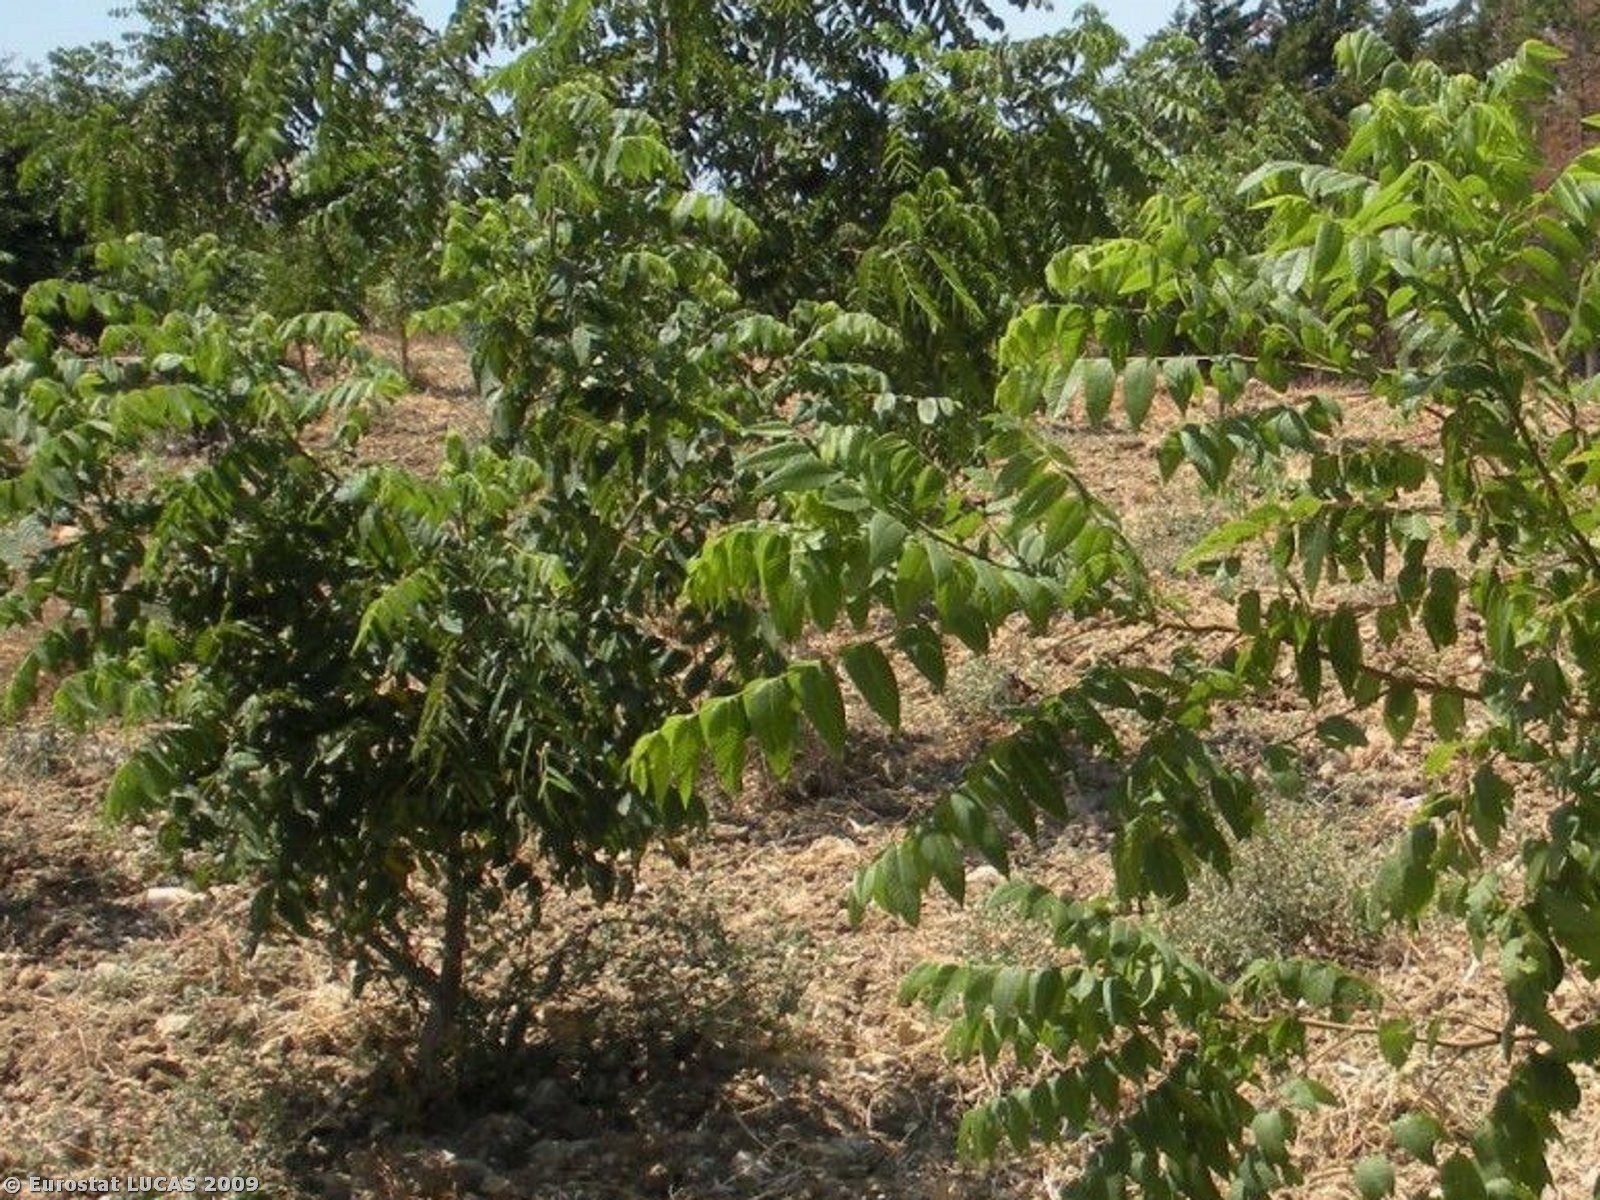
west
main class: Cropland
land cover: Nuts trees
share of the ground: 25 - 50 %
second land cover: Bare land
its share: > 75 %
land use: Agriculture (excluding fallow land and kitchen gardens)
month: July
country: IT
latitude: 38.0379
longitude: 12.6358
